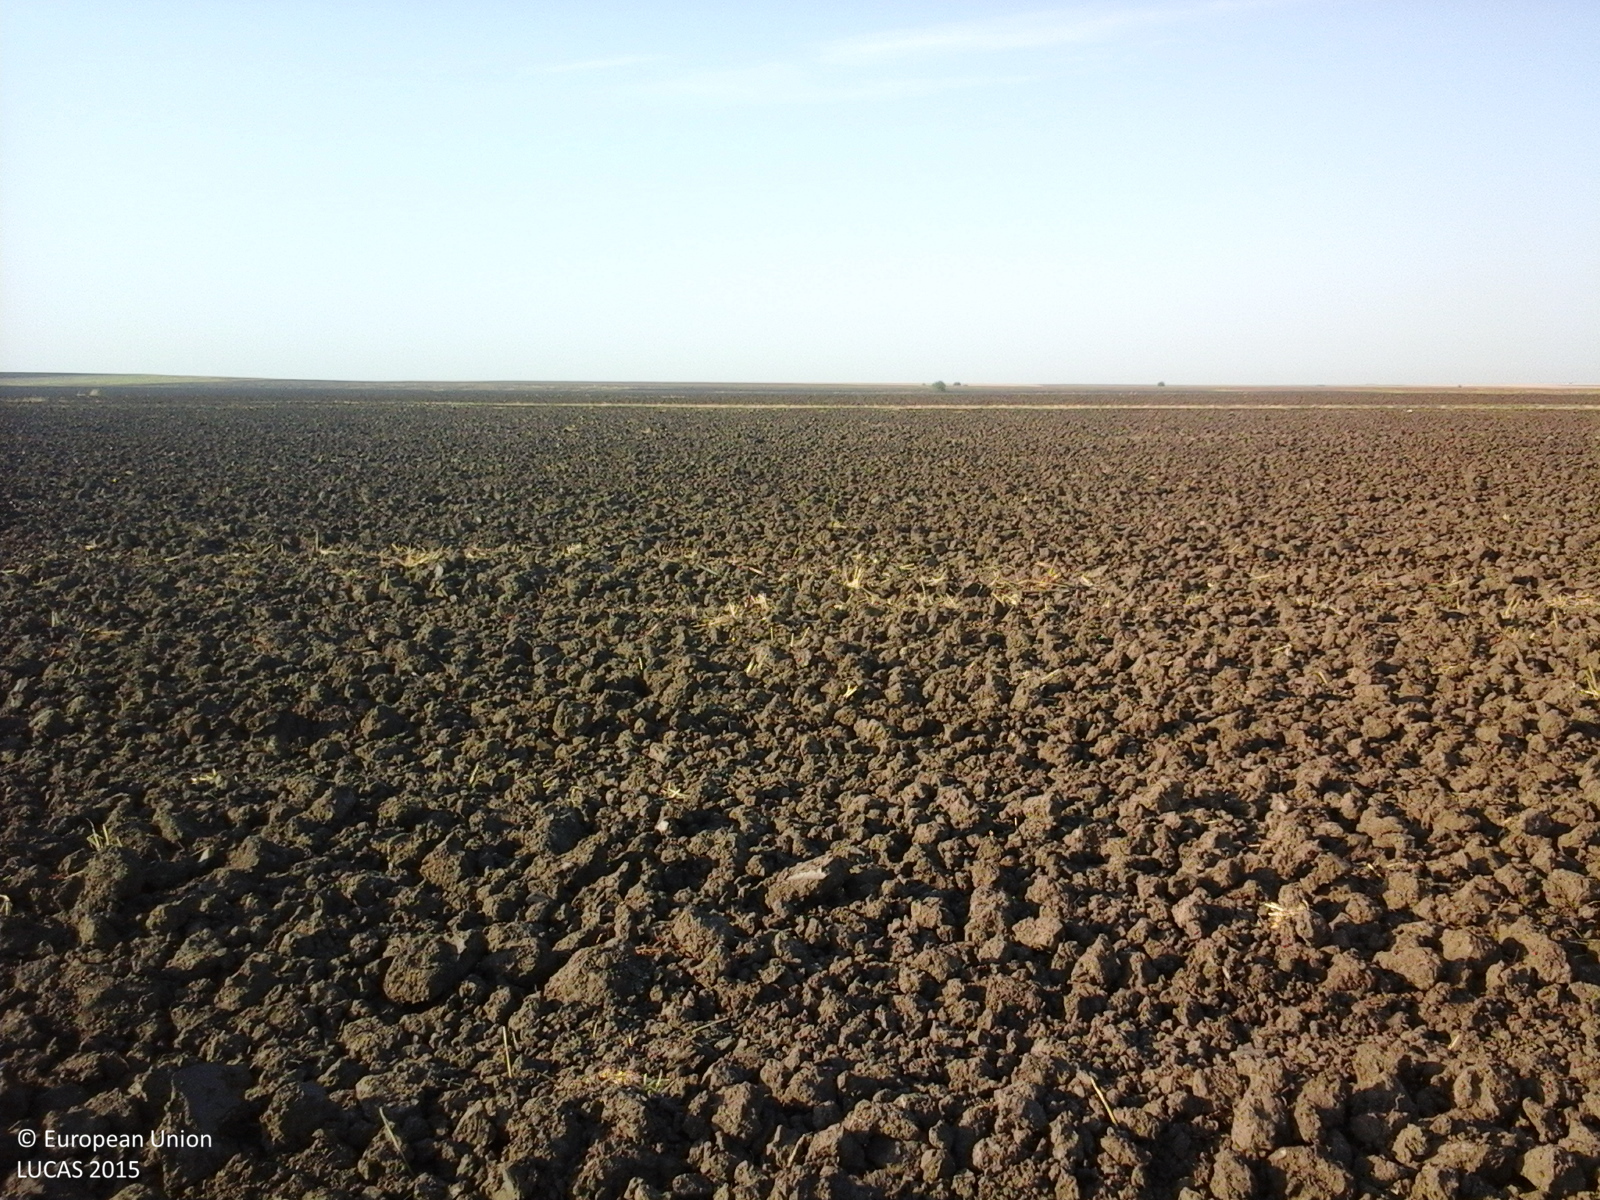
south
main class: Cropland
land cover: Common wheat
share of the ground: < 10 %
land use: Agriculture (excluding fallow land and kitchen gardens)
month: August
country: RO
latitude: 44.0200
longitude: 23.7129
